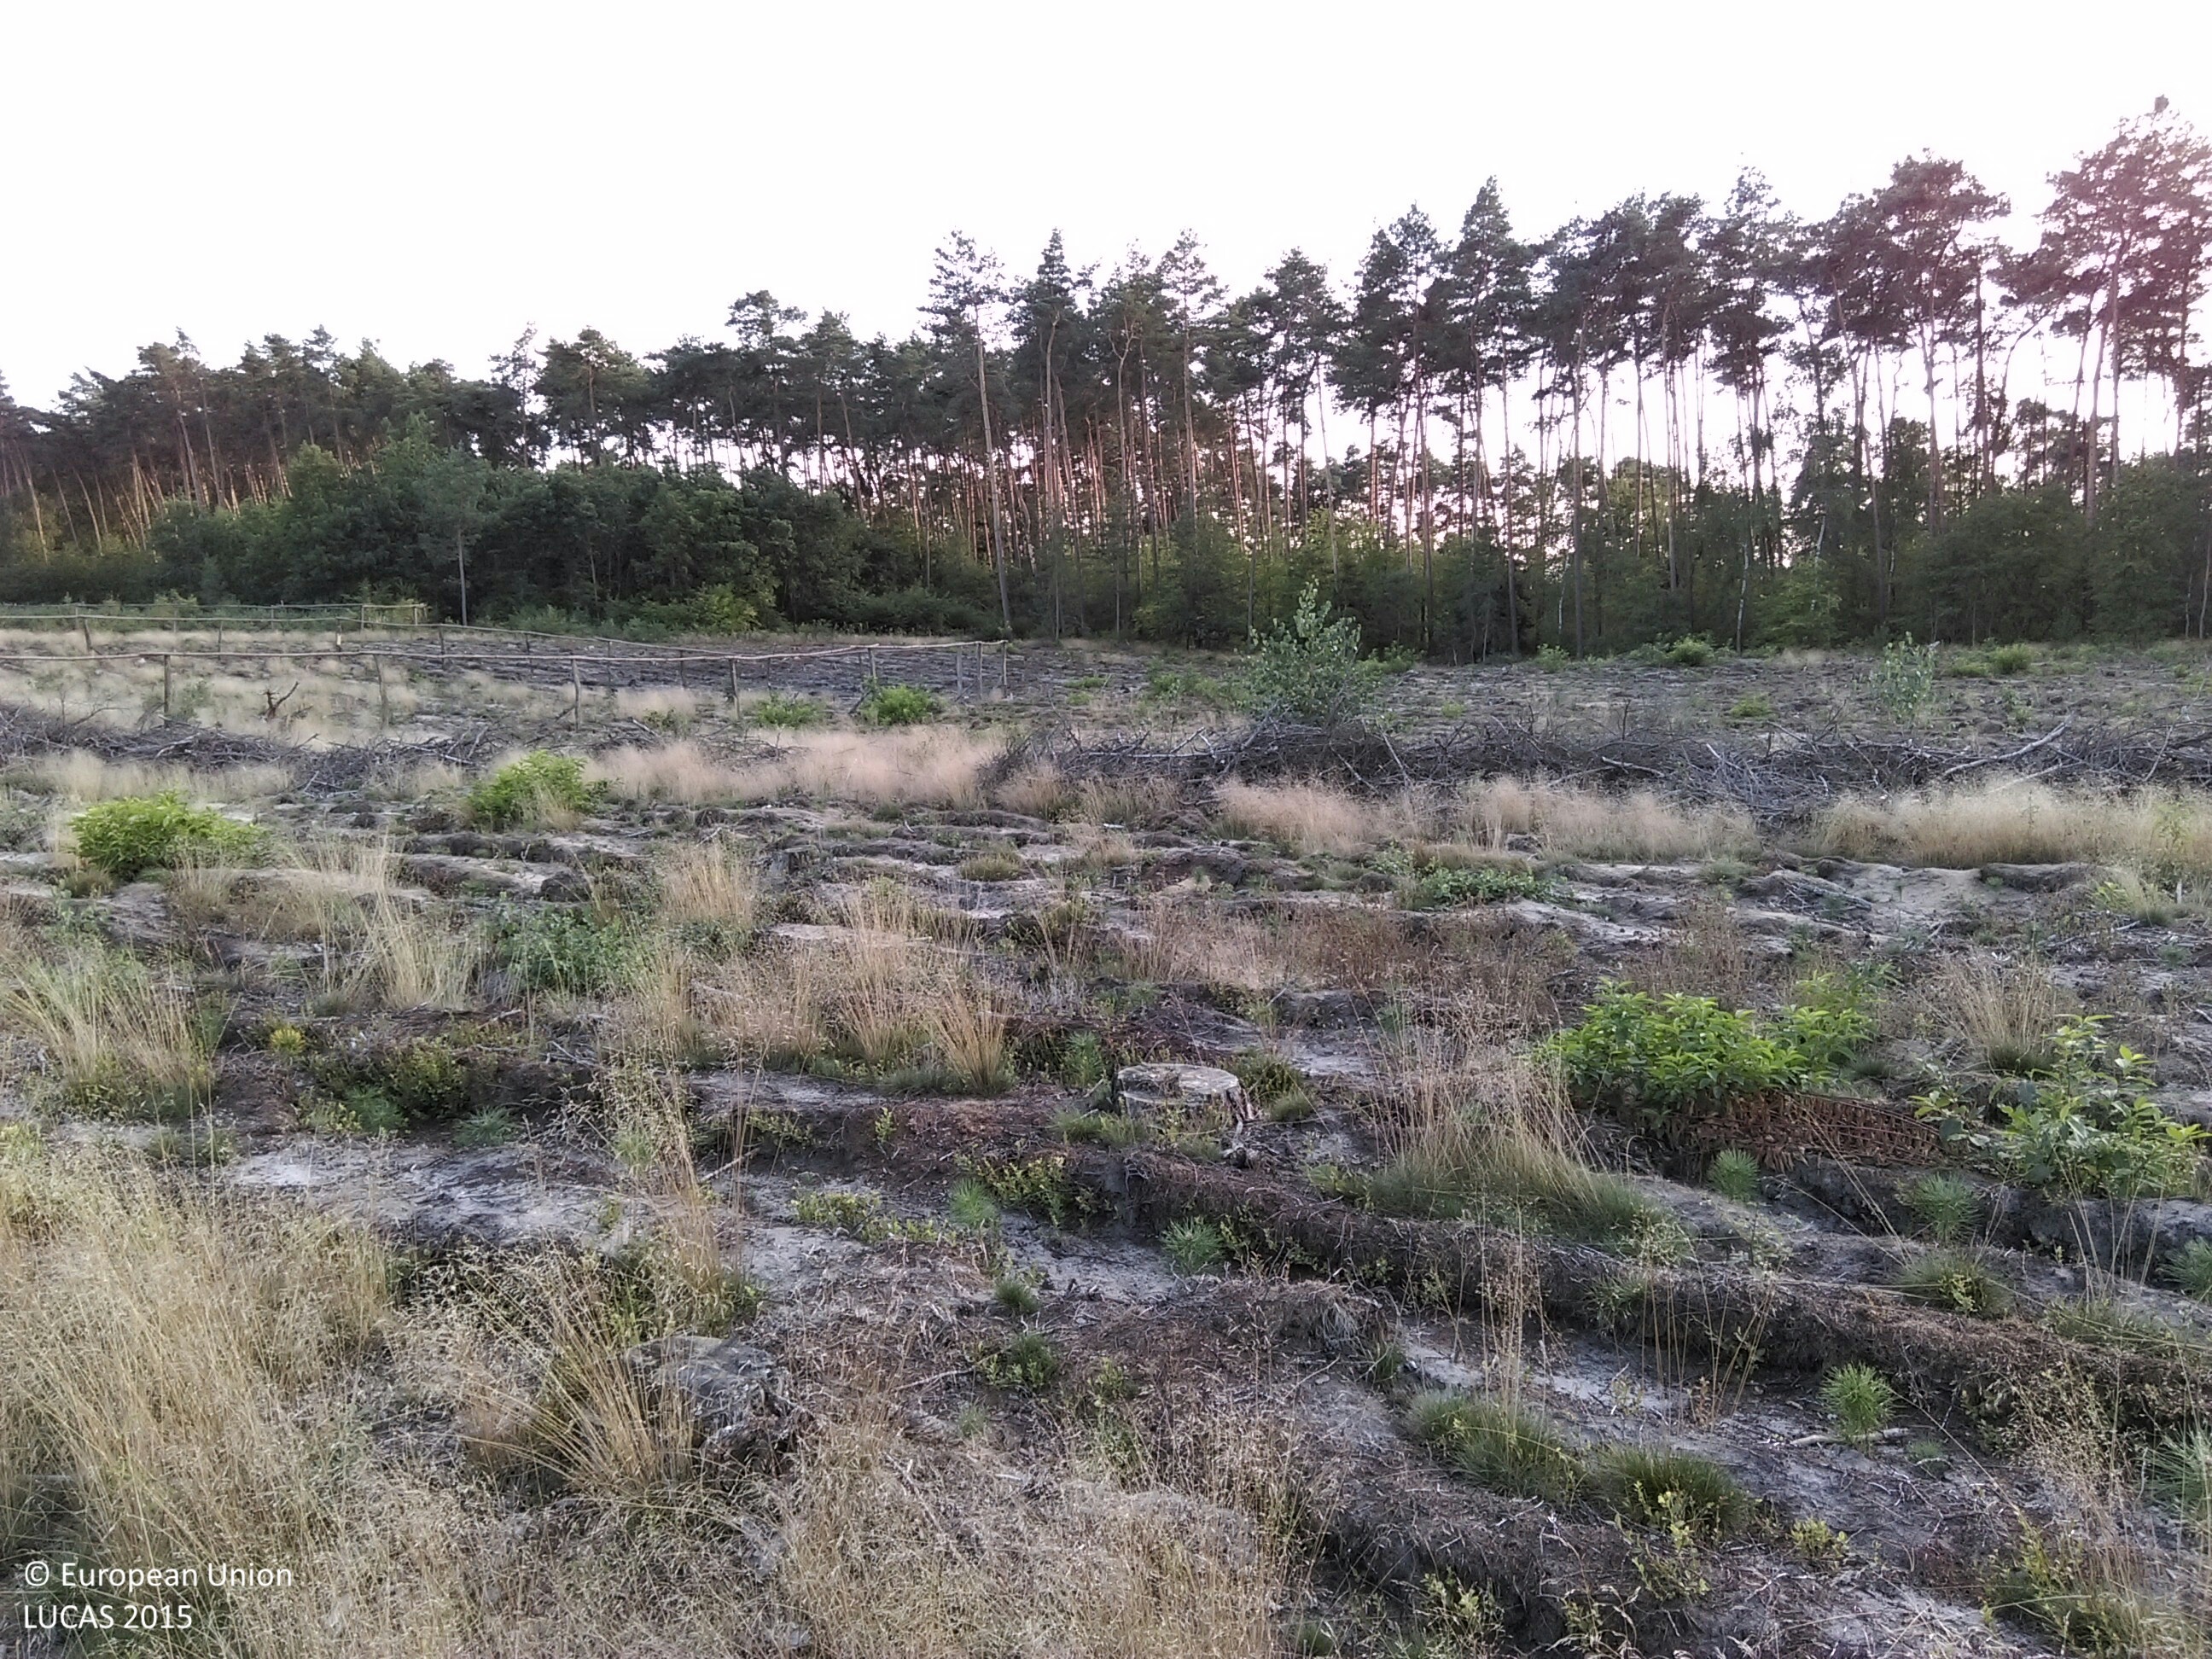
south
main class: Woodland
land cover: Pine dominated coniferous woodland
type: hemiboreal forest and nemoral coniferous forest and mixed broadleaved-coniferous forest
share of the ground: 10 - 25 %
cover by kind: herbaceous plants 50 %, unconsolidated bare surface 30 %, coniferous forest trees 20 %
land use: Forestry
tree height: < 5 m
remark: Clear cut
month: September
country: PL
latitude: 52.1588
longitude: 16.2484
